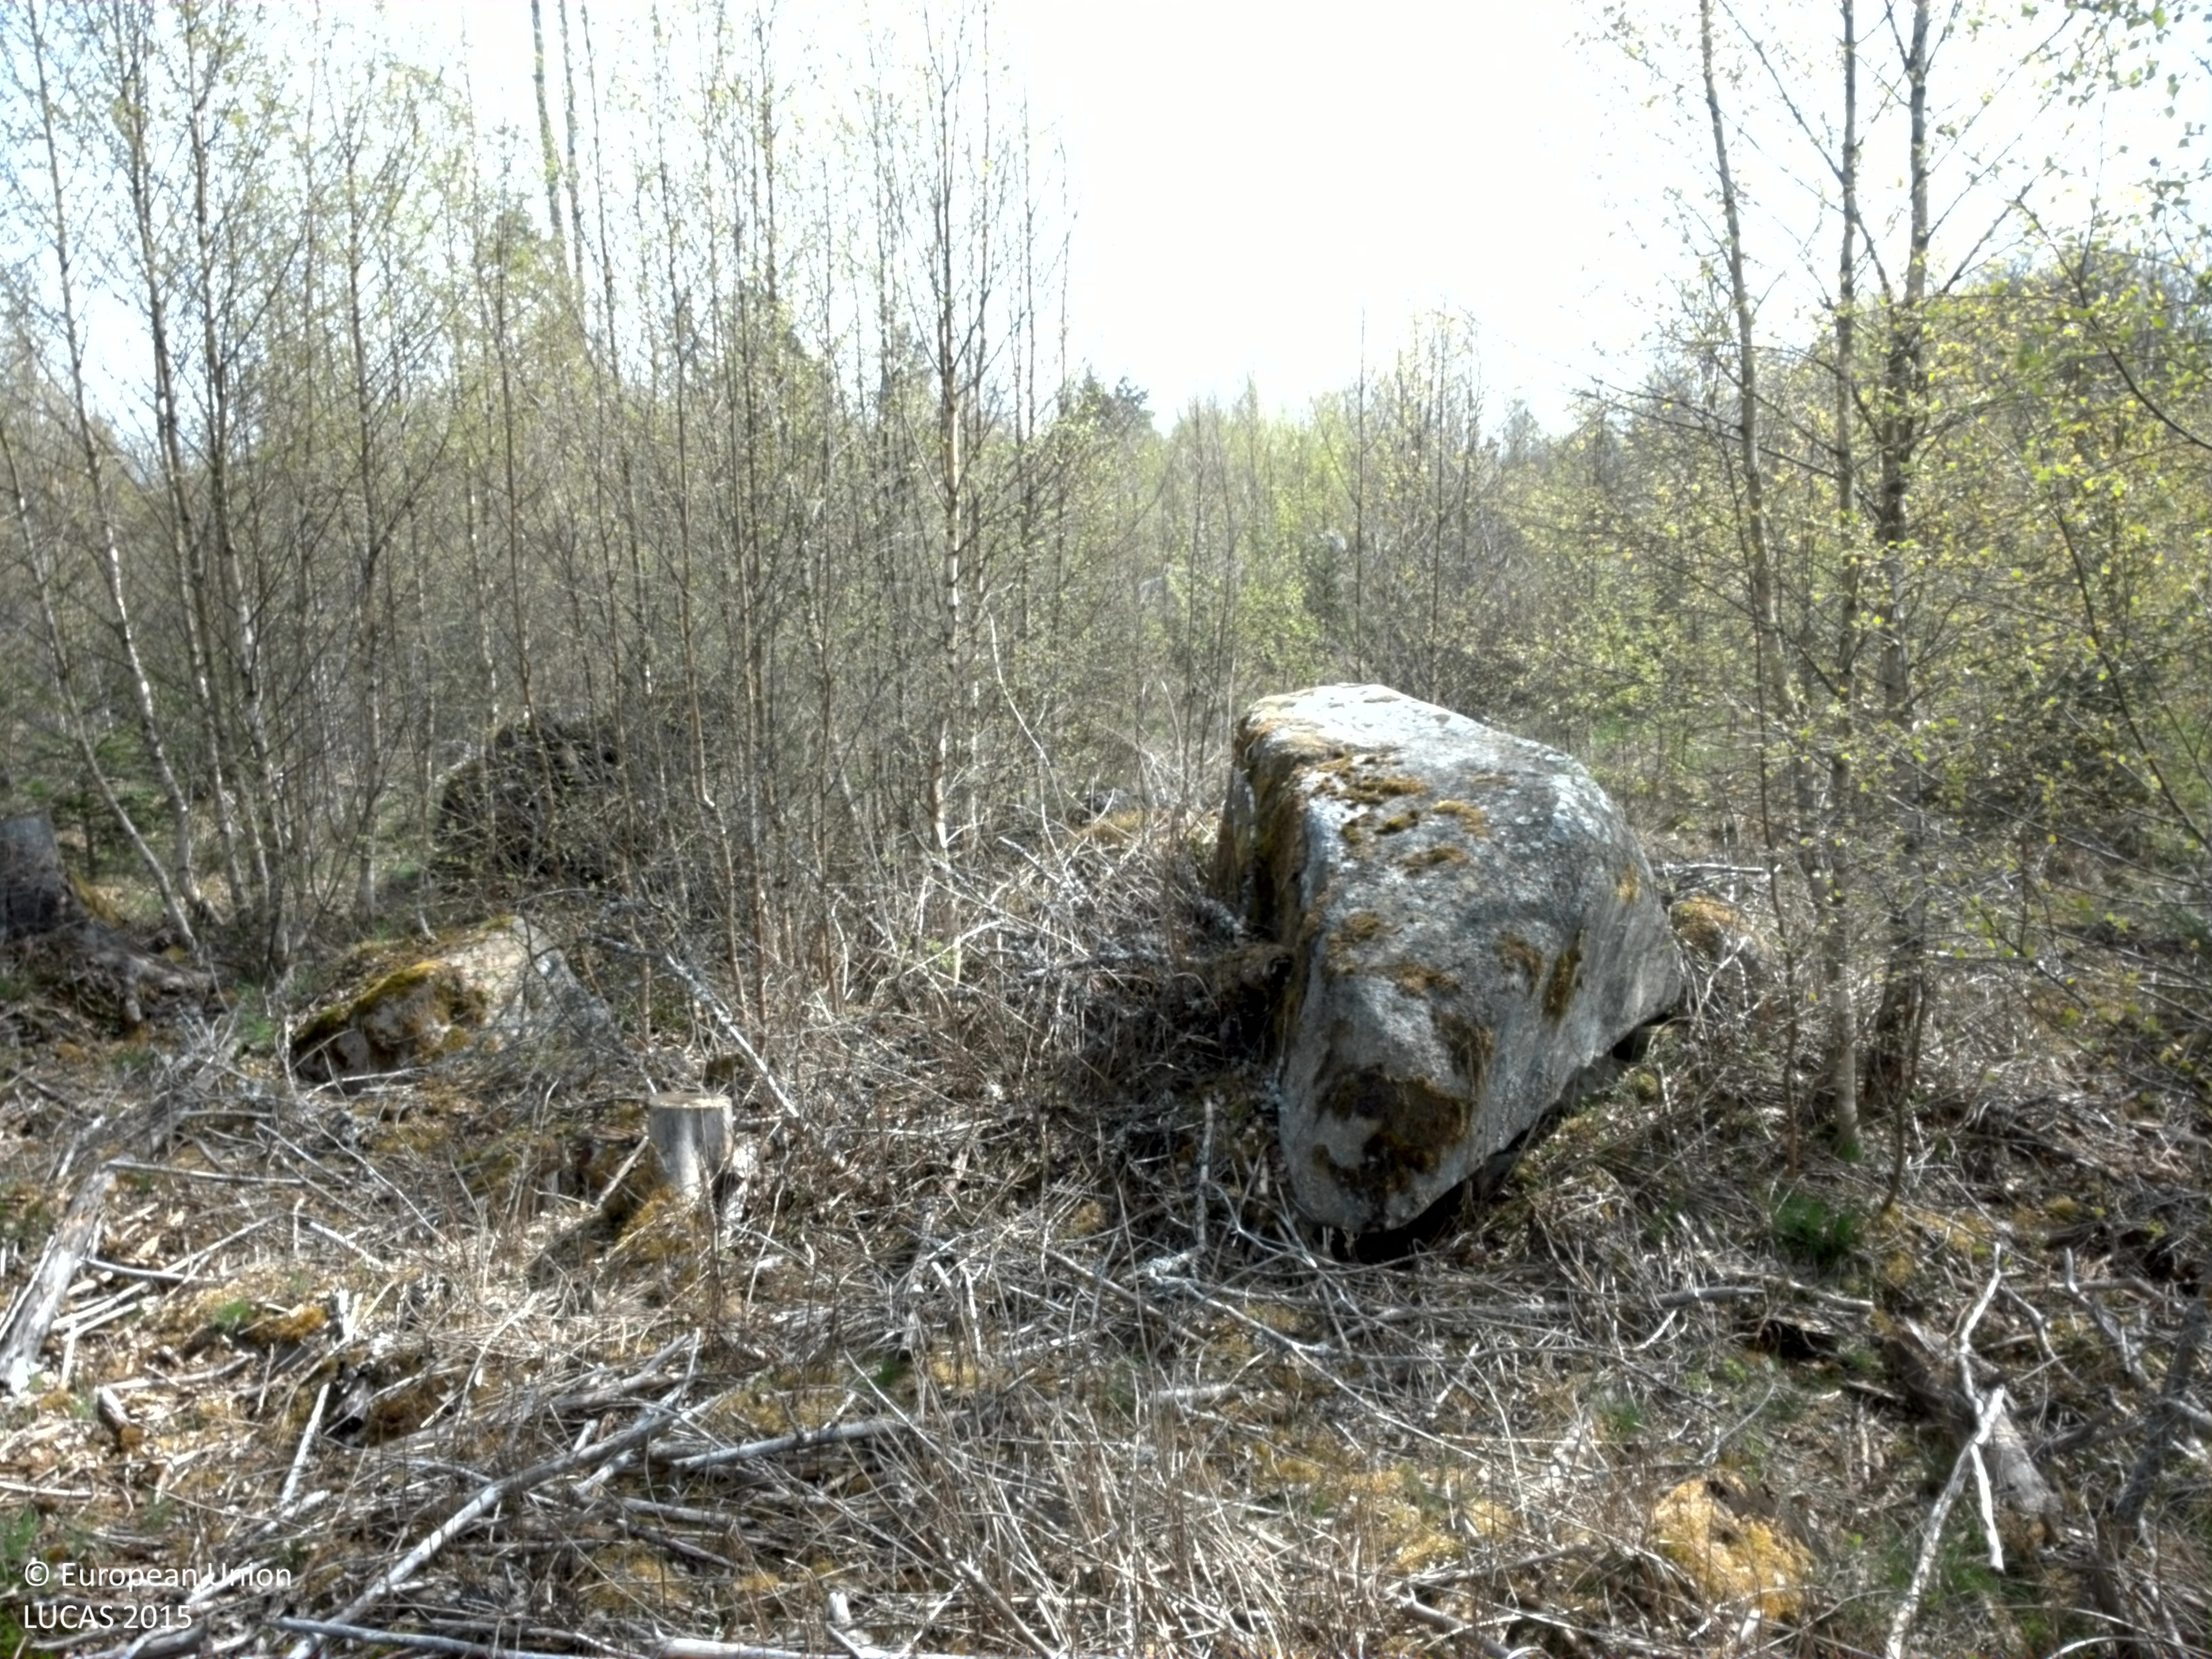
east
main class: Woodland
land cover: Broadleaved woodland
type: boreal forest
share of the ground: > 75 %
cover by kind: broadleaved forest trees 75 %, coniferous forest trees 15 %, shrubs 5 %, herbaceous plants 5 %
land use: Forestry
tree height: < 5 m
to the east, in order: Broadleaved woodland; Ditches and canals; Tracks; Fences; Grassland without tree/shrub cover; Fences; Artificial constructions in urban areas
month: May
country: SE
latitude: 56.7995
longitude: 14.8278
